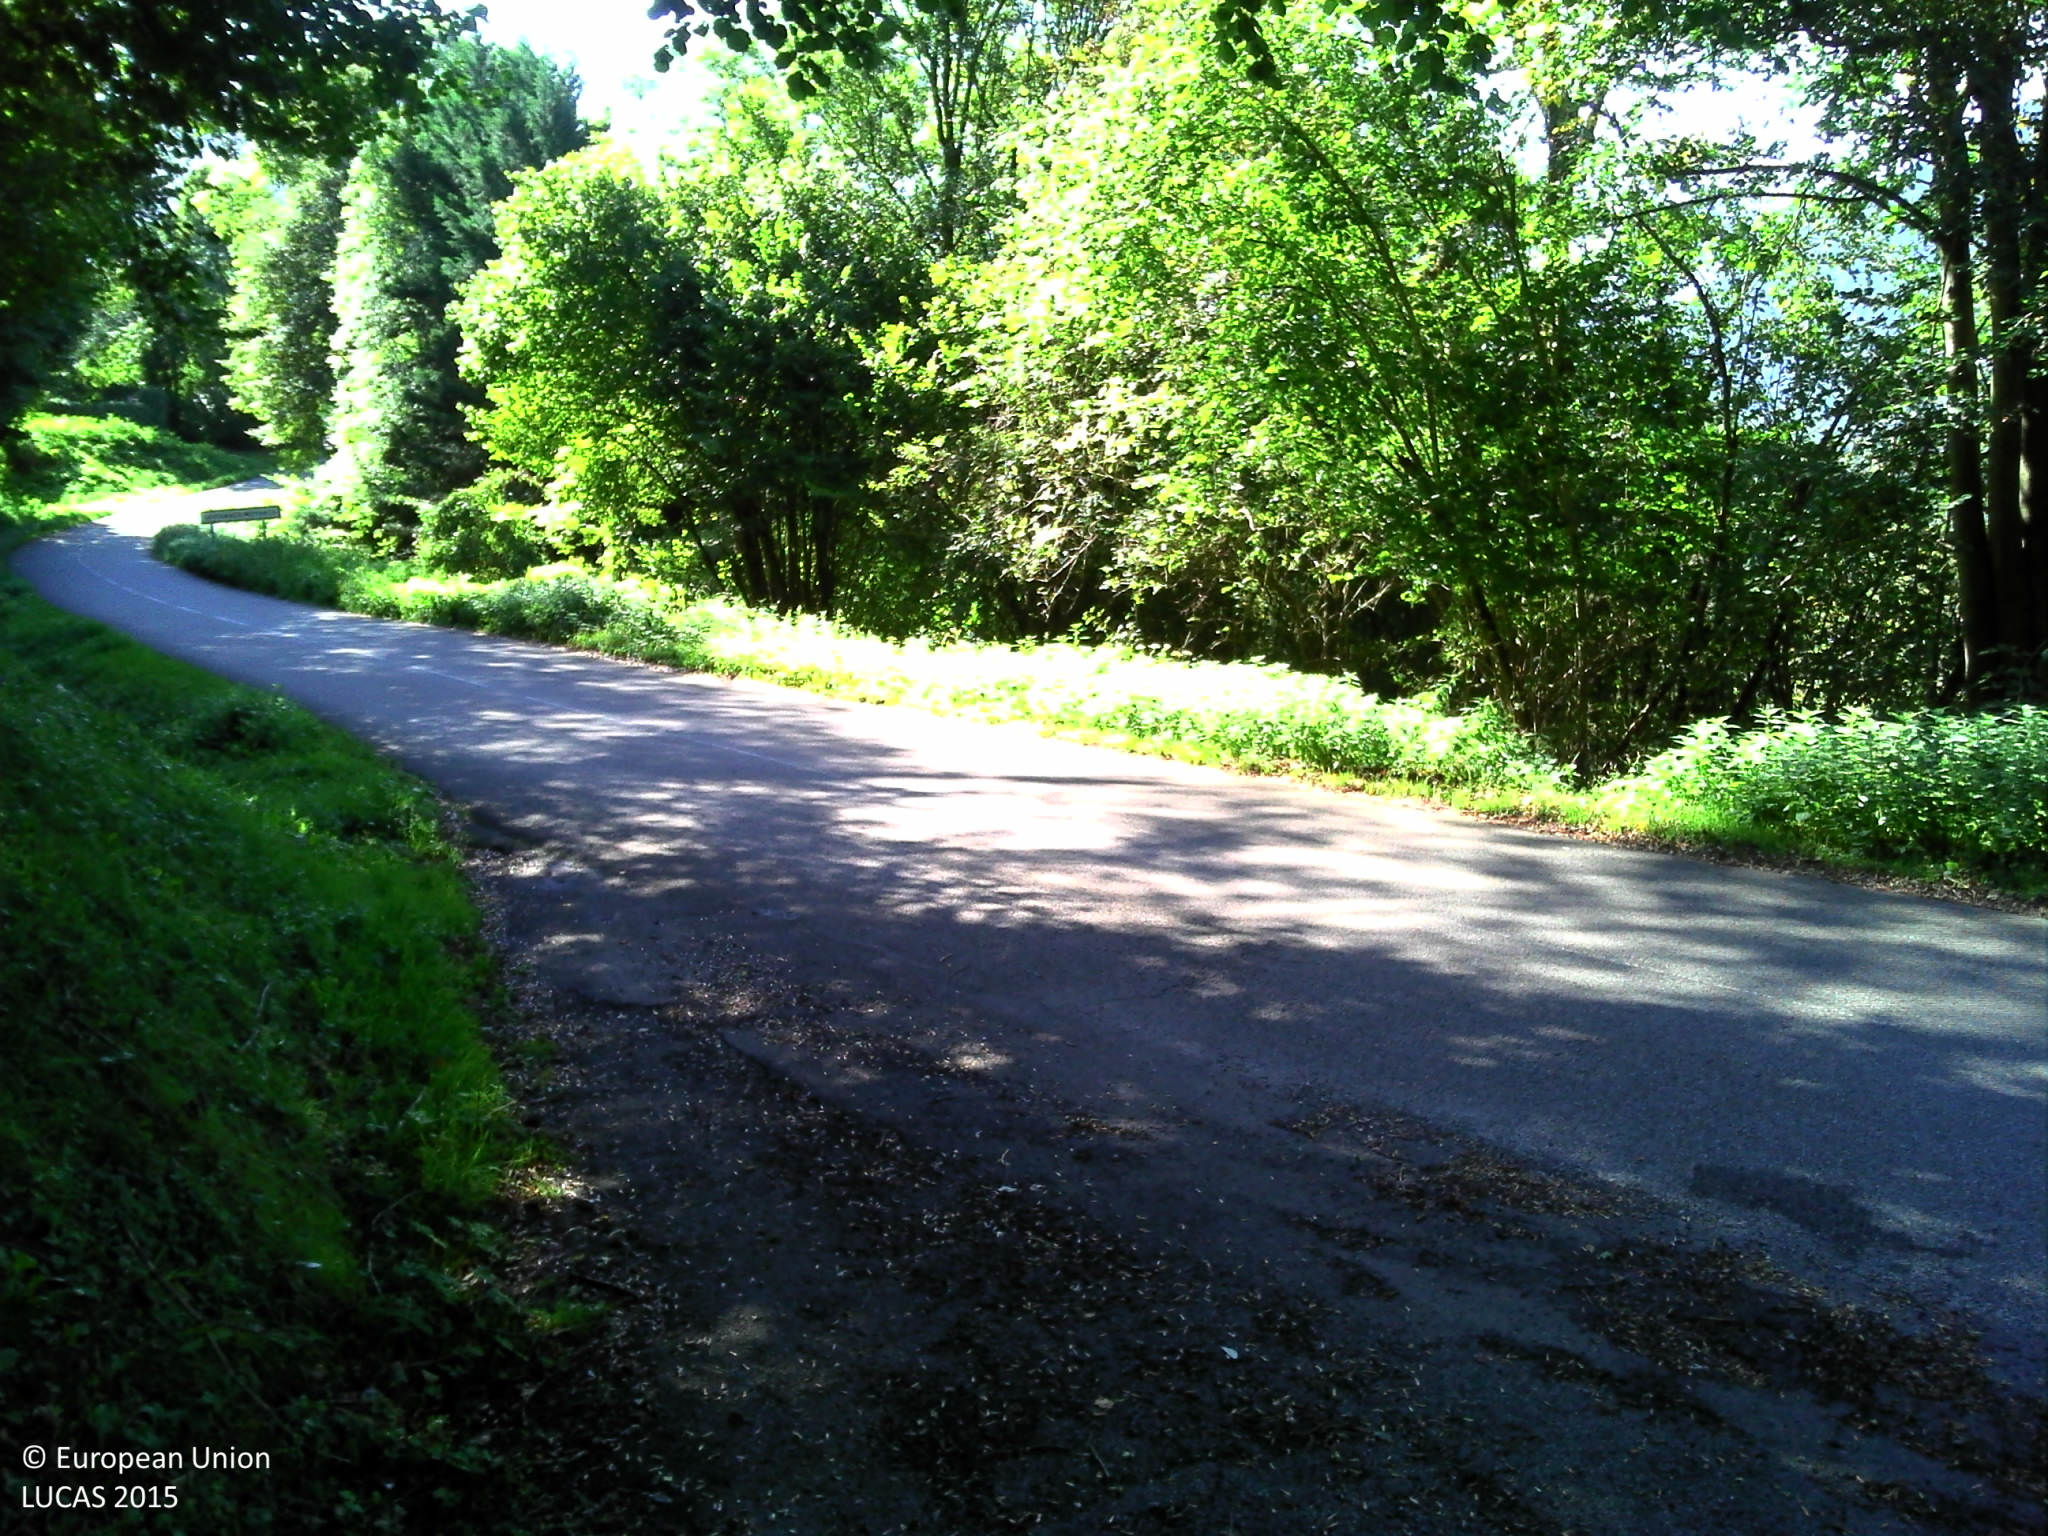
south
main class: Woodland
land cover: Broadleaved woodland
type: non-riverine alder, birch or aspen forest
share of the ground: > 75 %
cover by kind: broadleaved forest trees 65 %, shrubs 10 %, herbaceous plants 10 %, lichens and mosses 10 %, coniferous forest trees 5 %
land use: Forestry
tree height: > 5 m
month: September
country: FR
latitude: 43.1161
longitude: -0.4154
